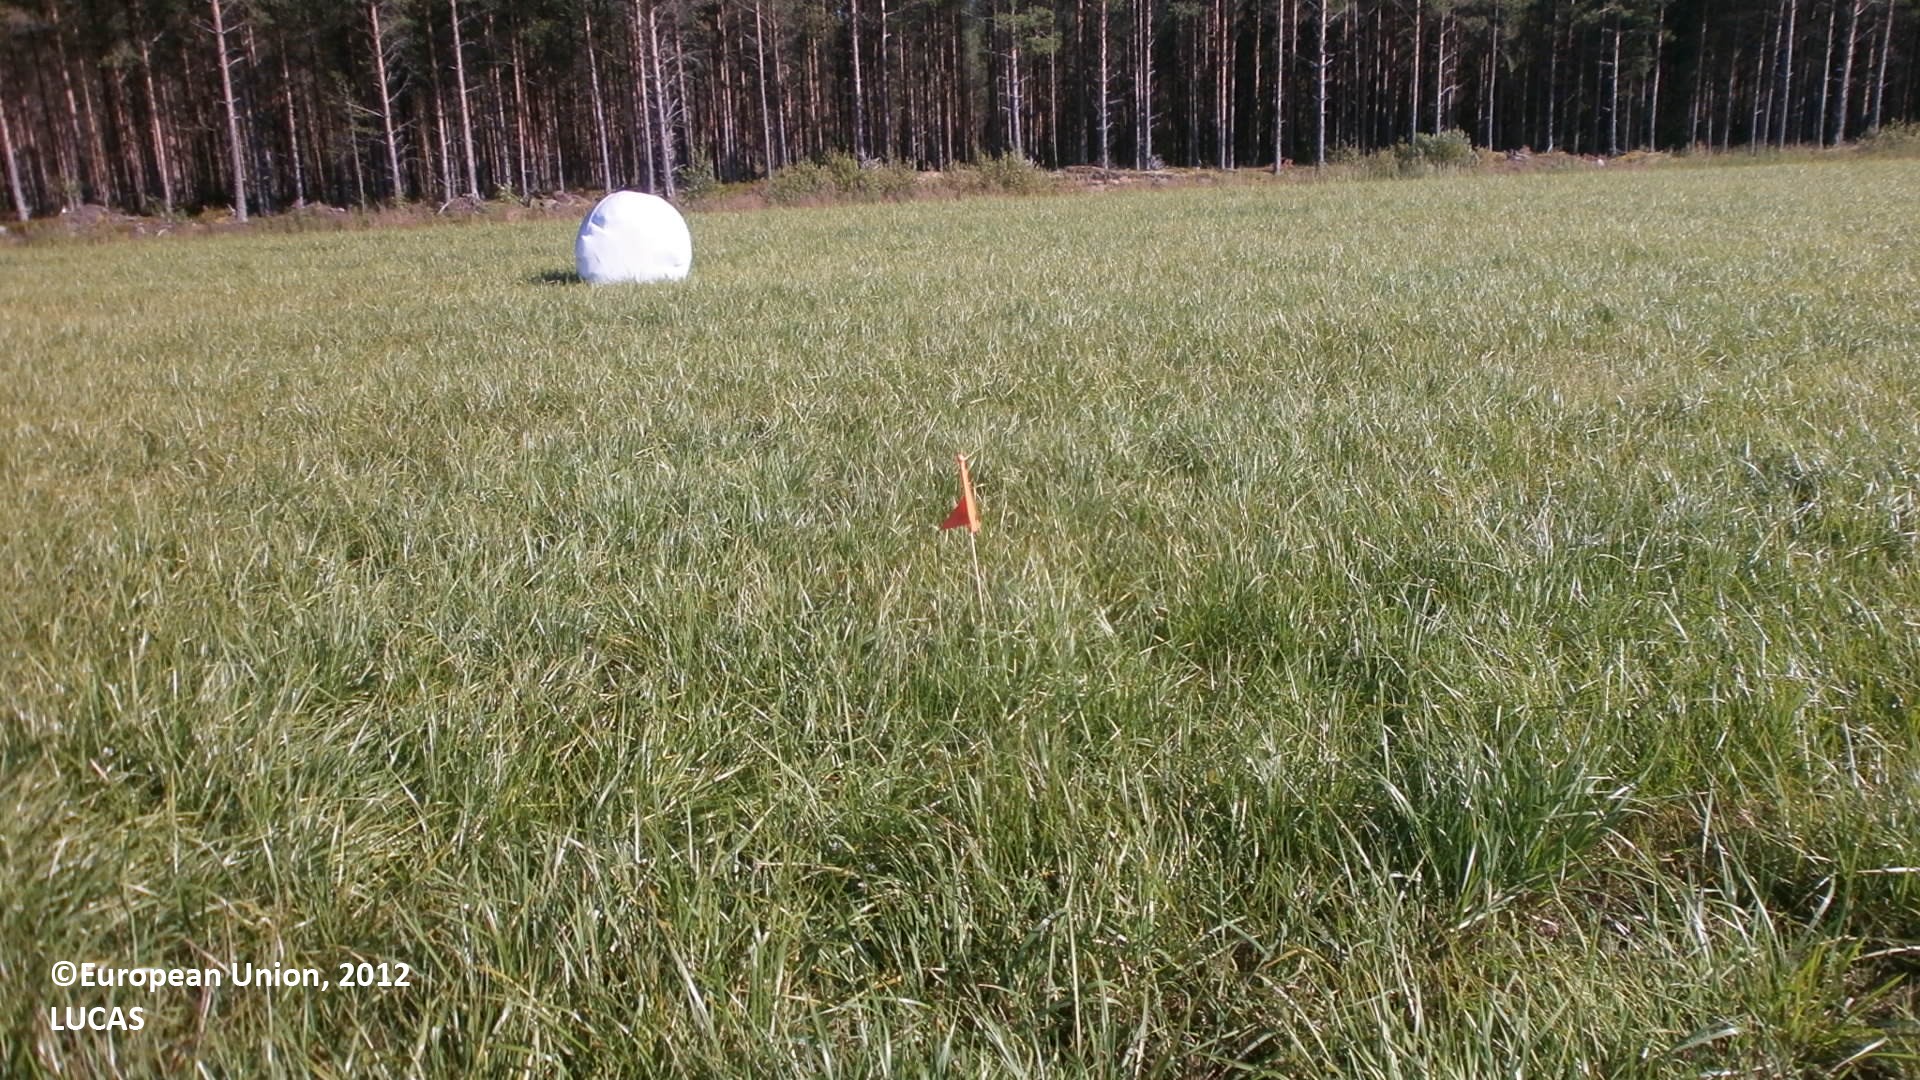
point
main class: Cropland
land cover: Temporary grasslands
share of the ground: > 75 %
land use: Agriculture (excluding fallow land and kitchen gardens)
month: July
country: FI
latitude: 64.1649
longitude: 23.9455
